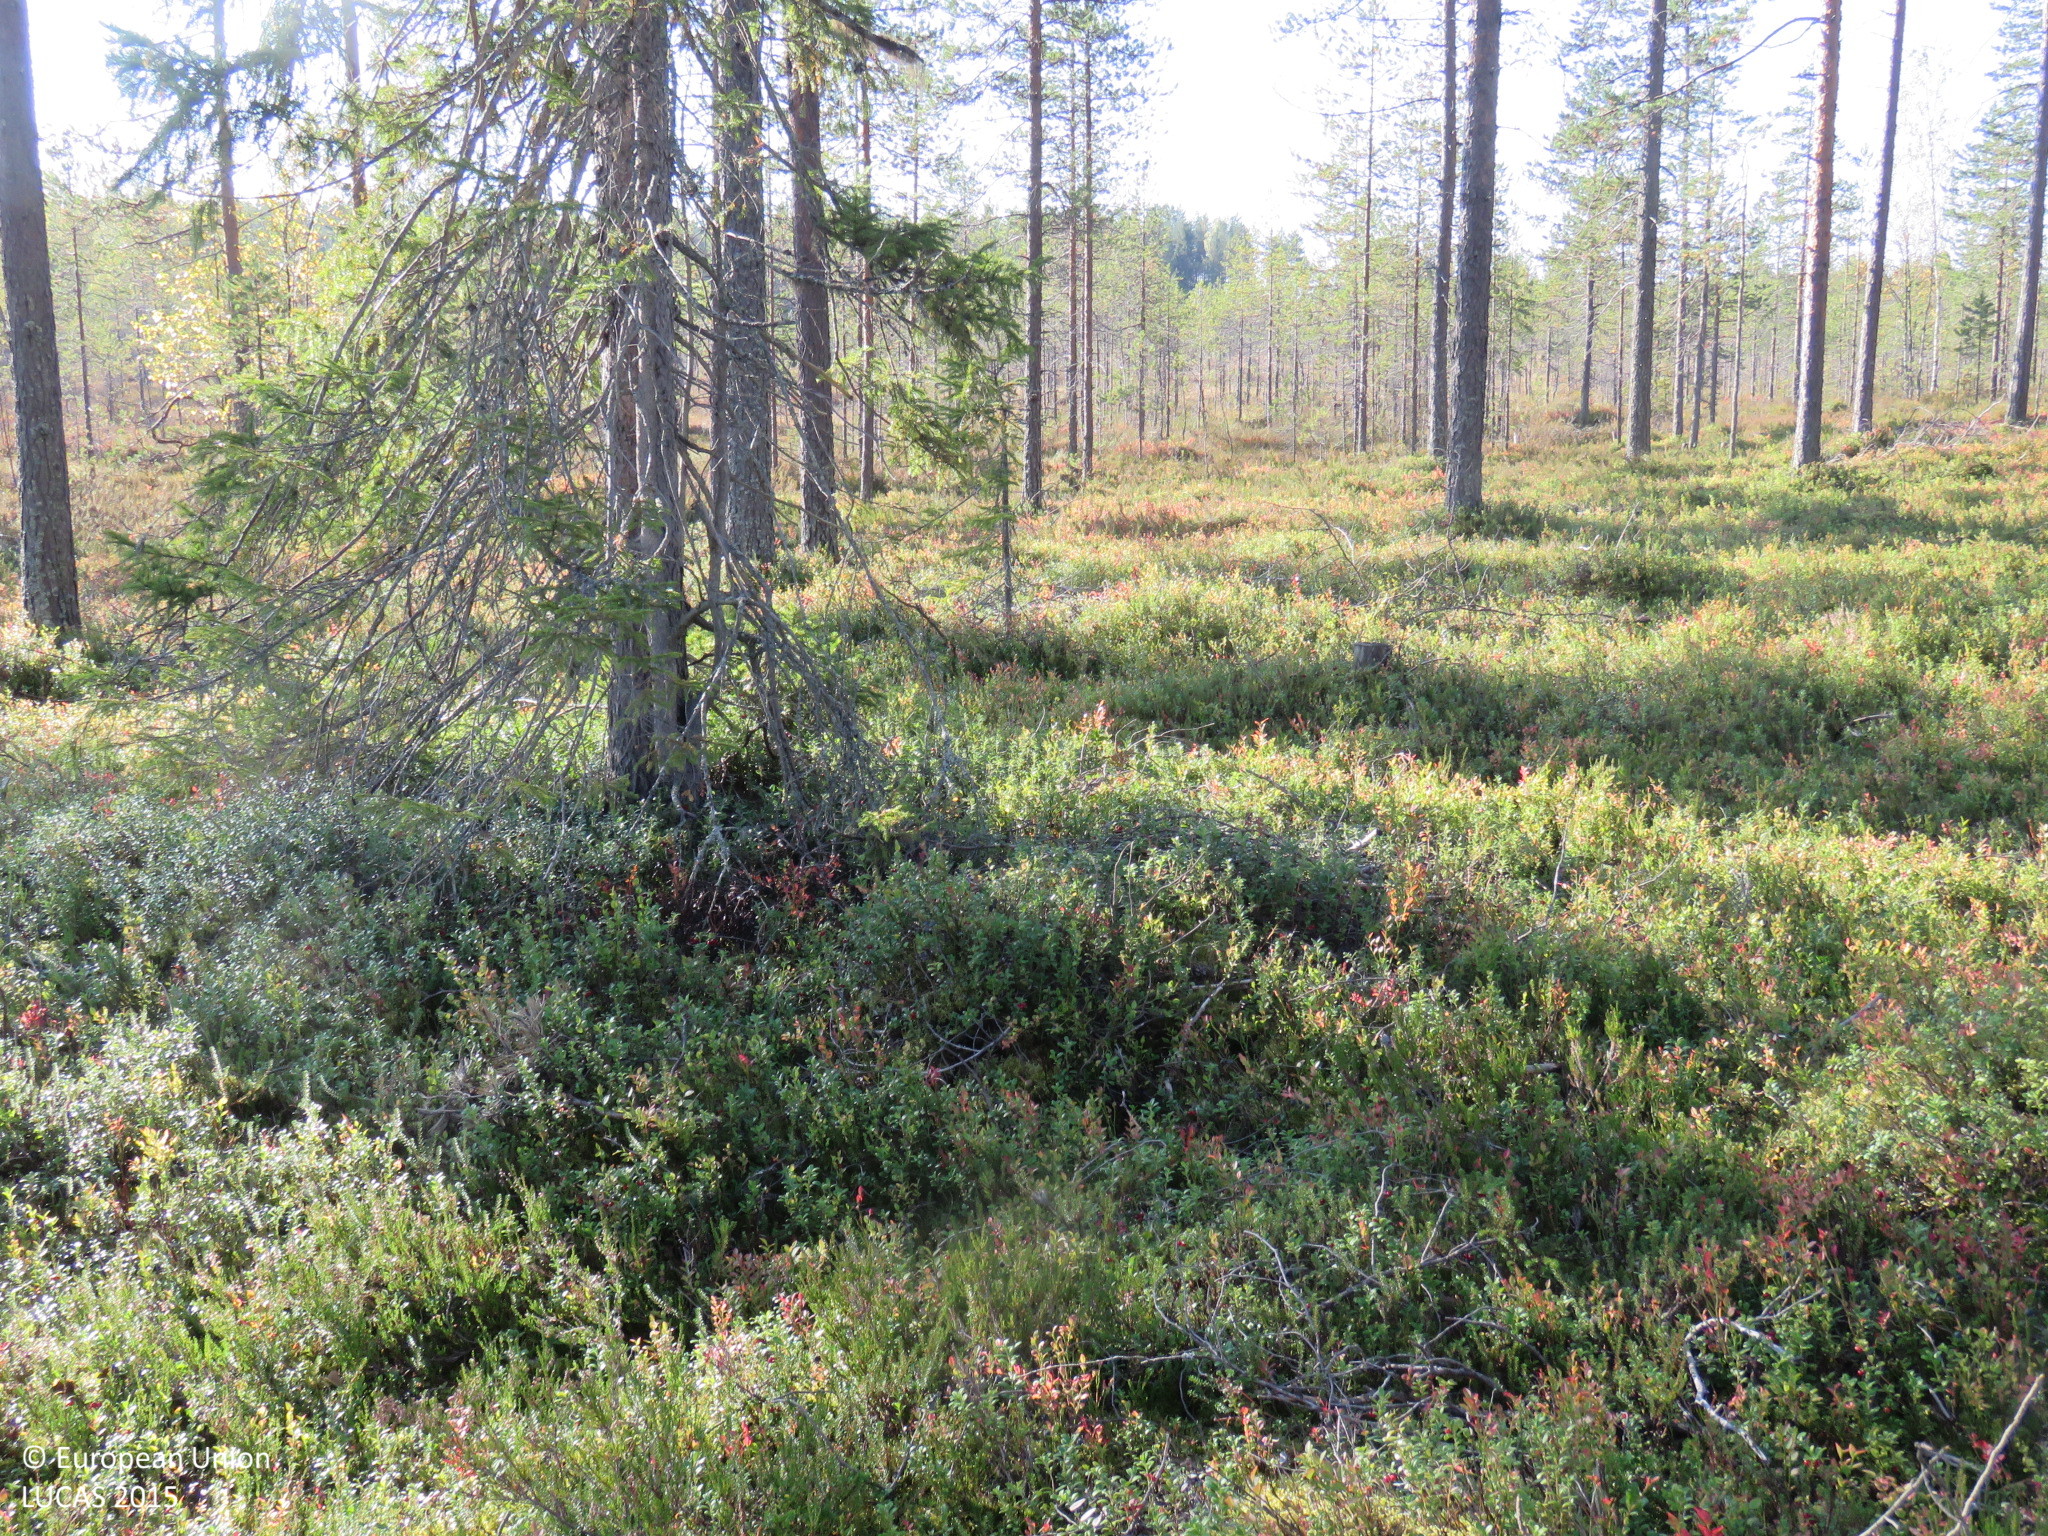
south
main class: Woodland
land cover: Pine dominated coniferous woodland
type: boreal forest
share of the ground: 50 - 75 %
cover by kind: coniferous forest trees 60 %, shrubs 30 %, lichens and mosses 10 %
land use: Forestry
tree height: > 5 m
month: September
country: FI
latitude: 64.9789
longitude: 26.9671
